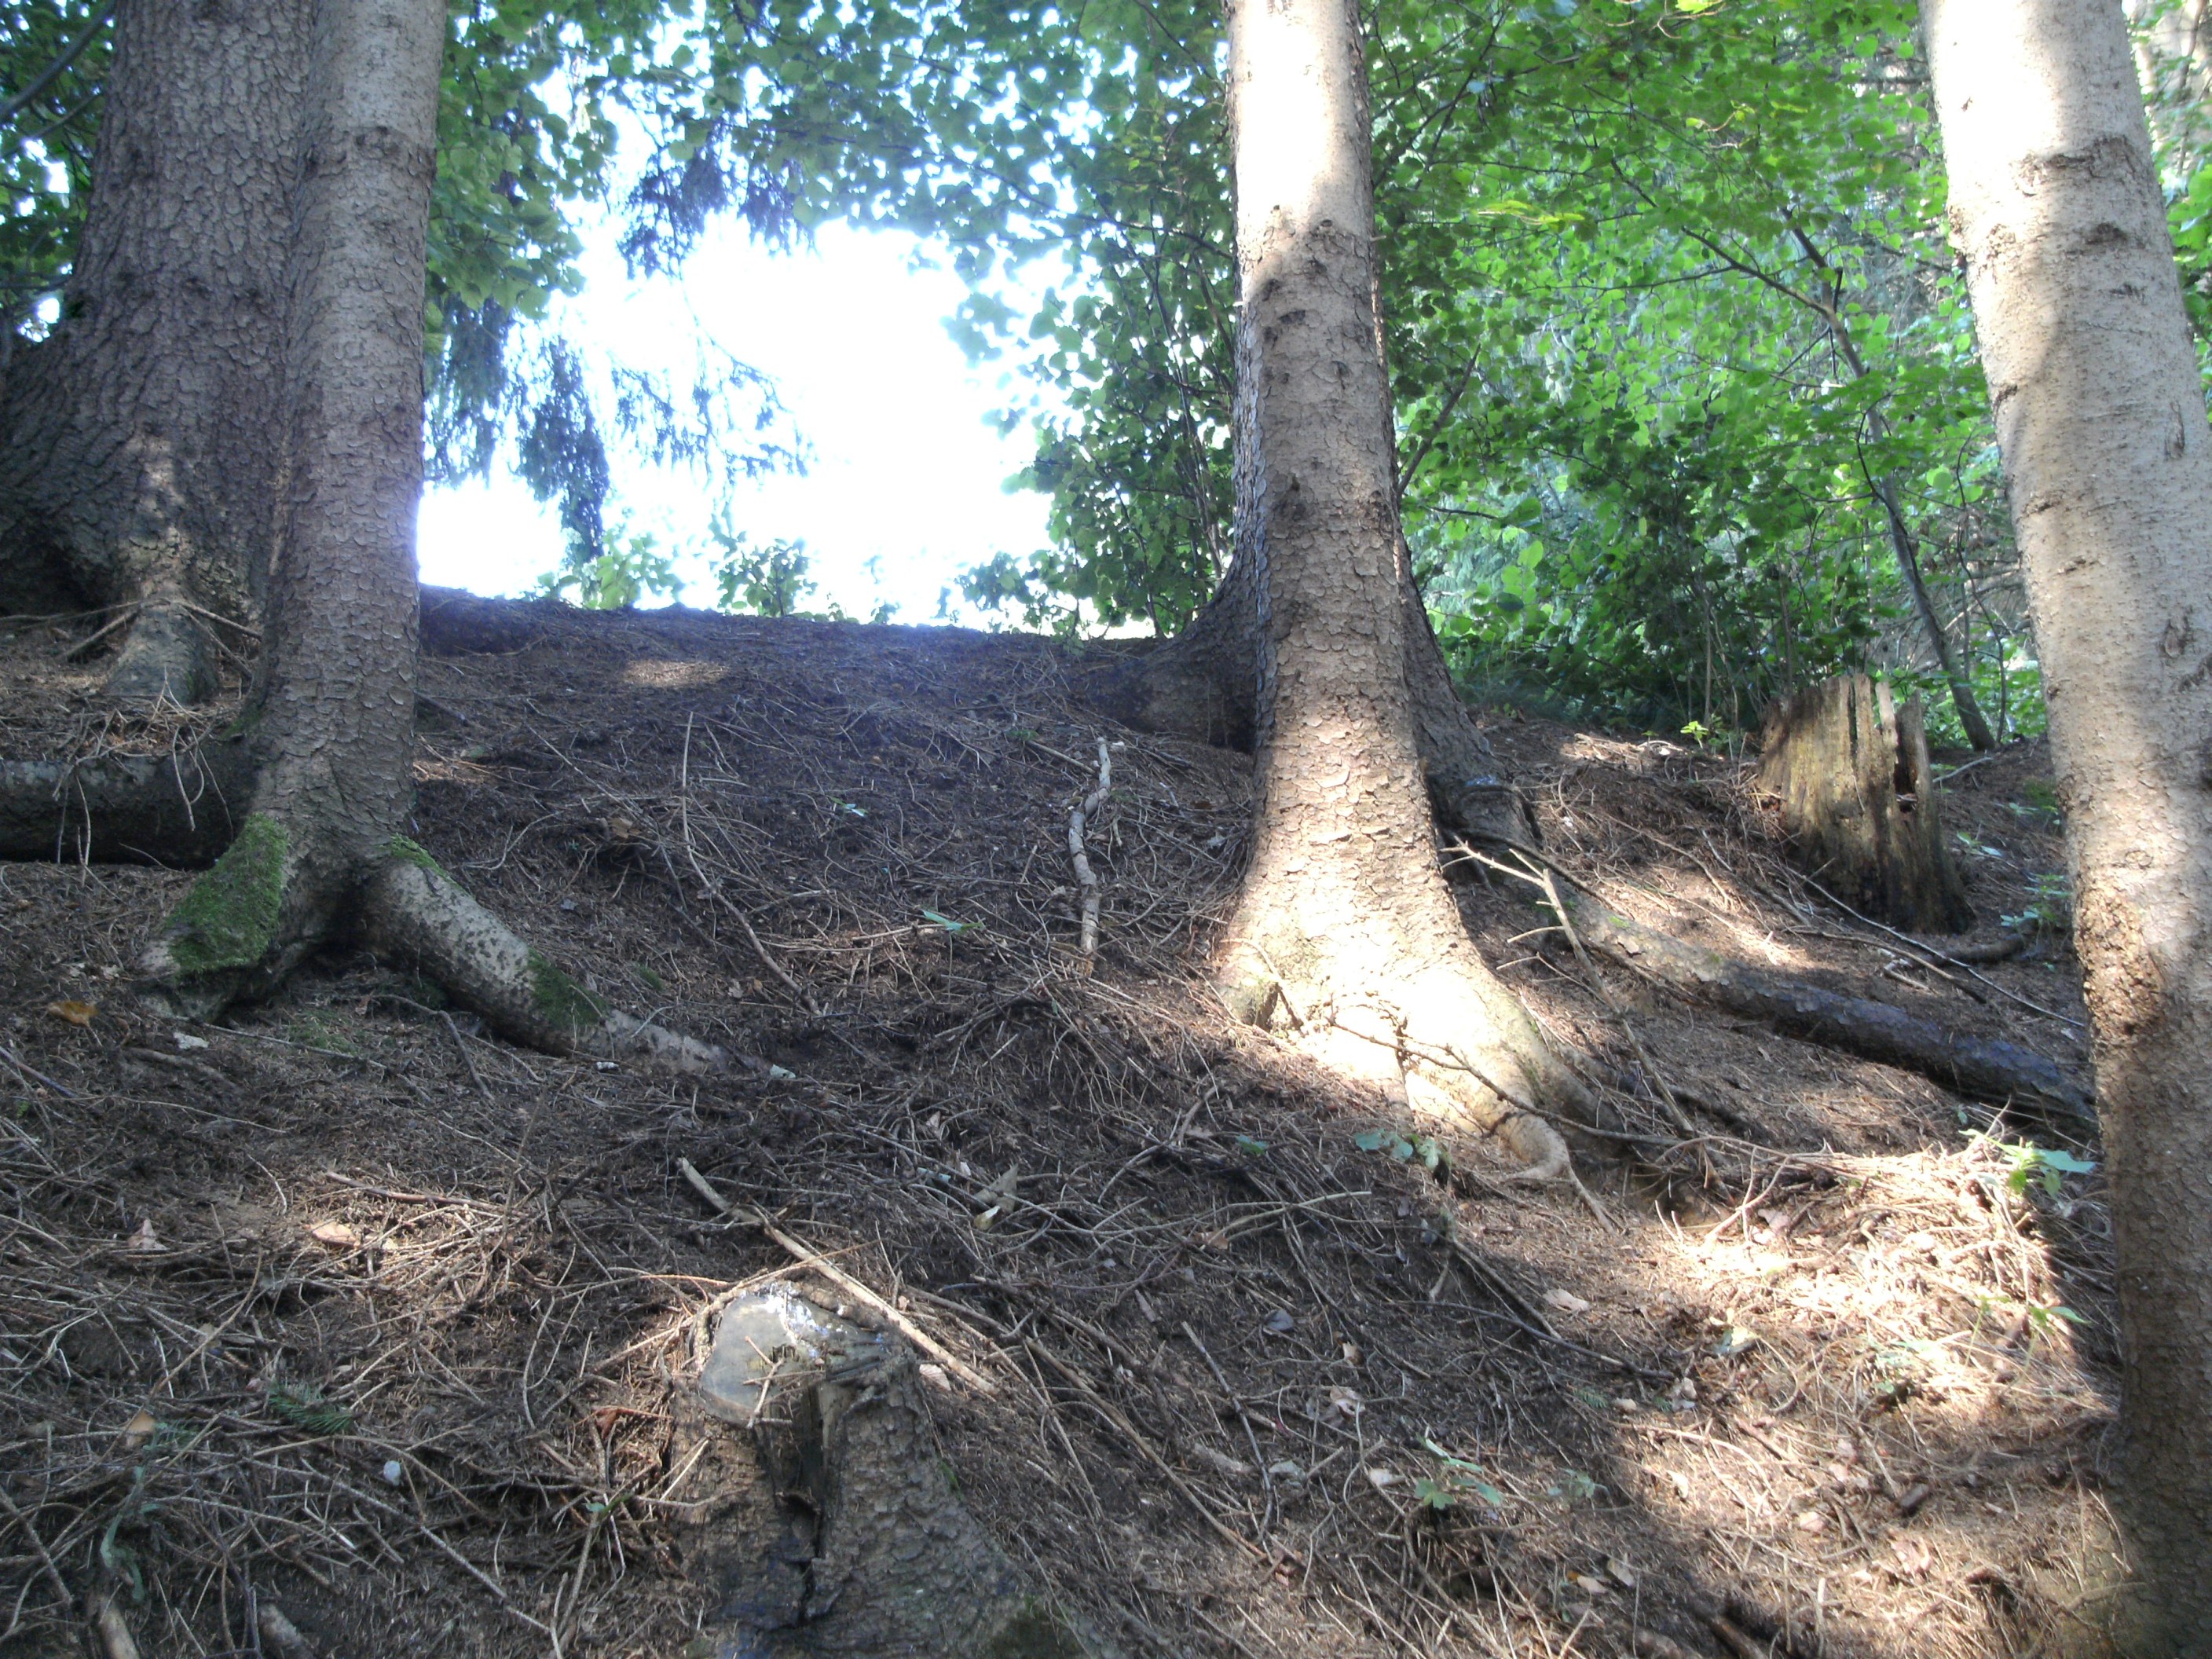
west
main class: Woodland
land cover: Spruce dominated coniferous woodland
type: hemiboreal forest and nemoral coniferous forest and mixed broadleaved-coniferous forest
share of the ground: > 75 %
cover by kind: coniferous forest trees 85 %, shrubs 10 %, unconsolidated bare surface 5 %
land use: Forestry
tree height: > 5 m
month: July
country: AT
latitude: 46.6708
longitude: 14.9260
